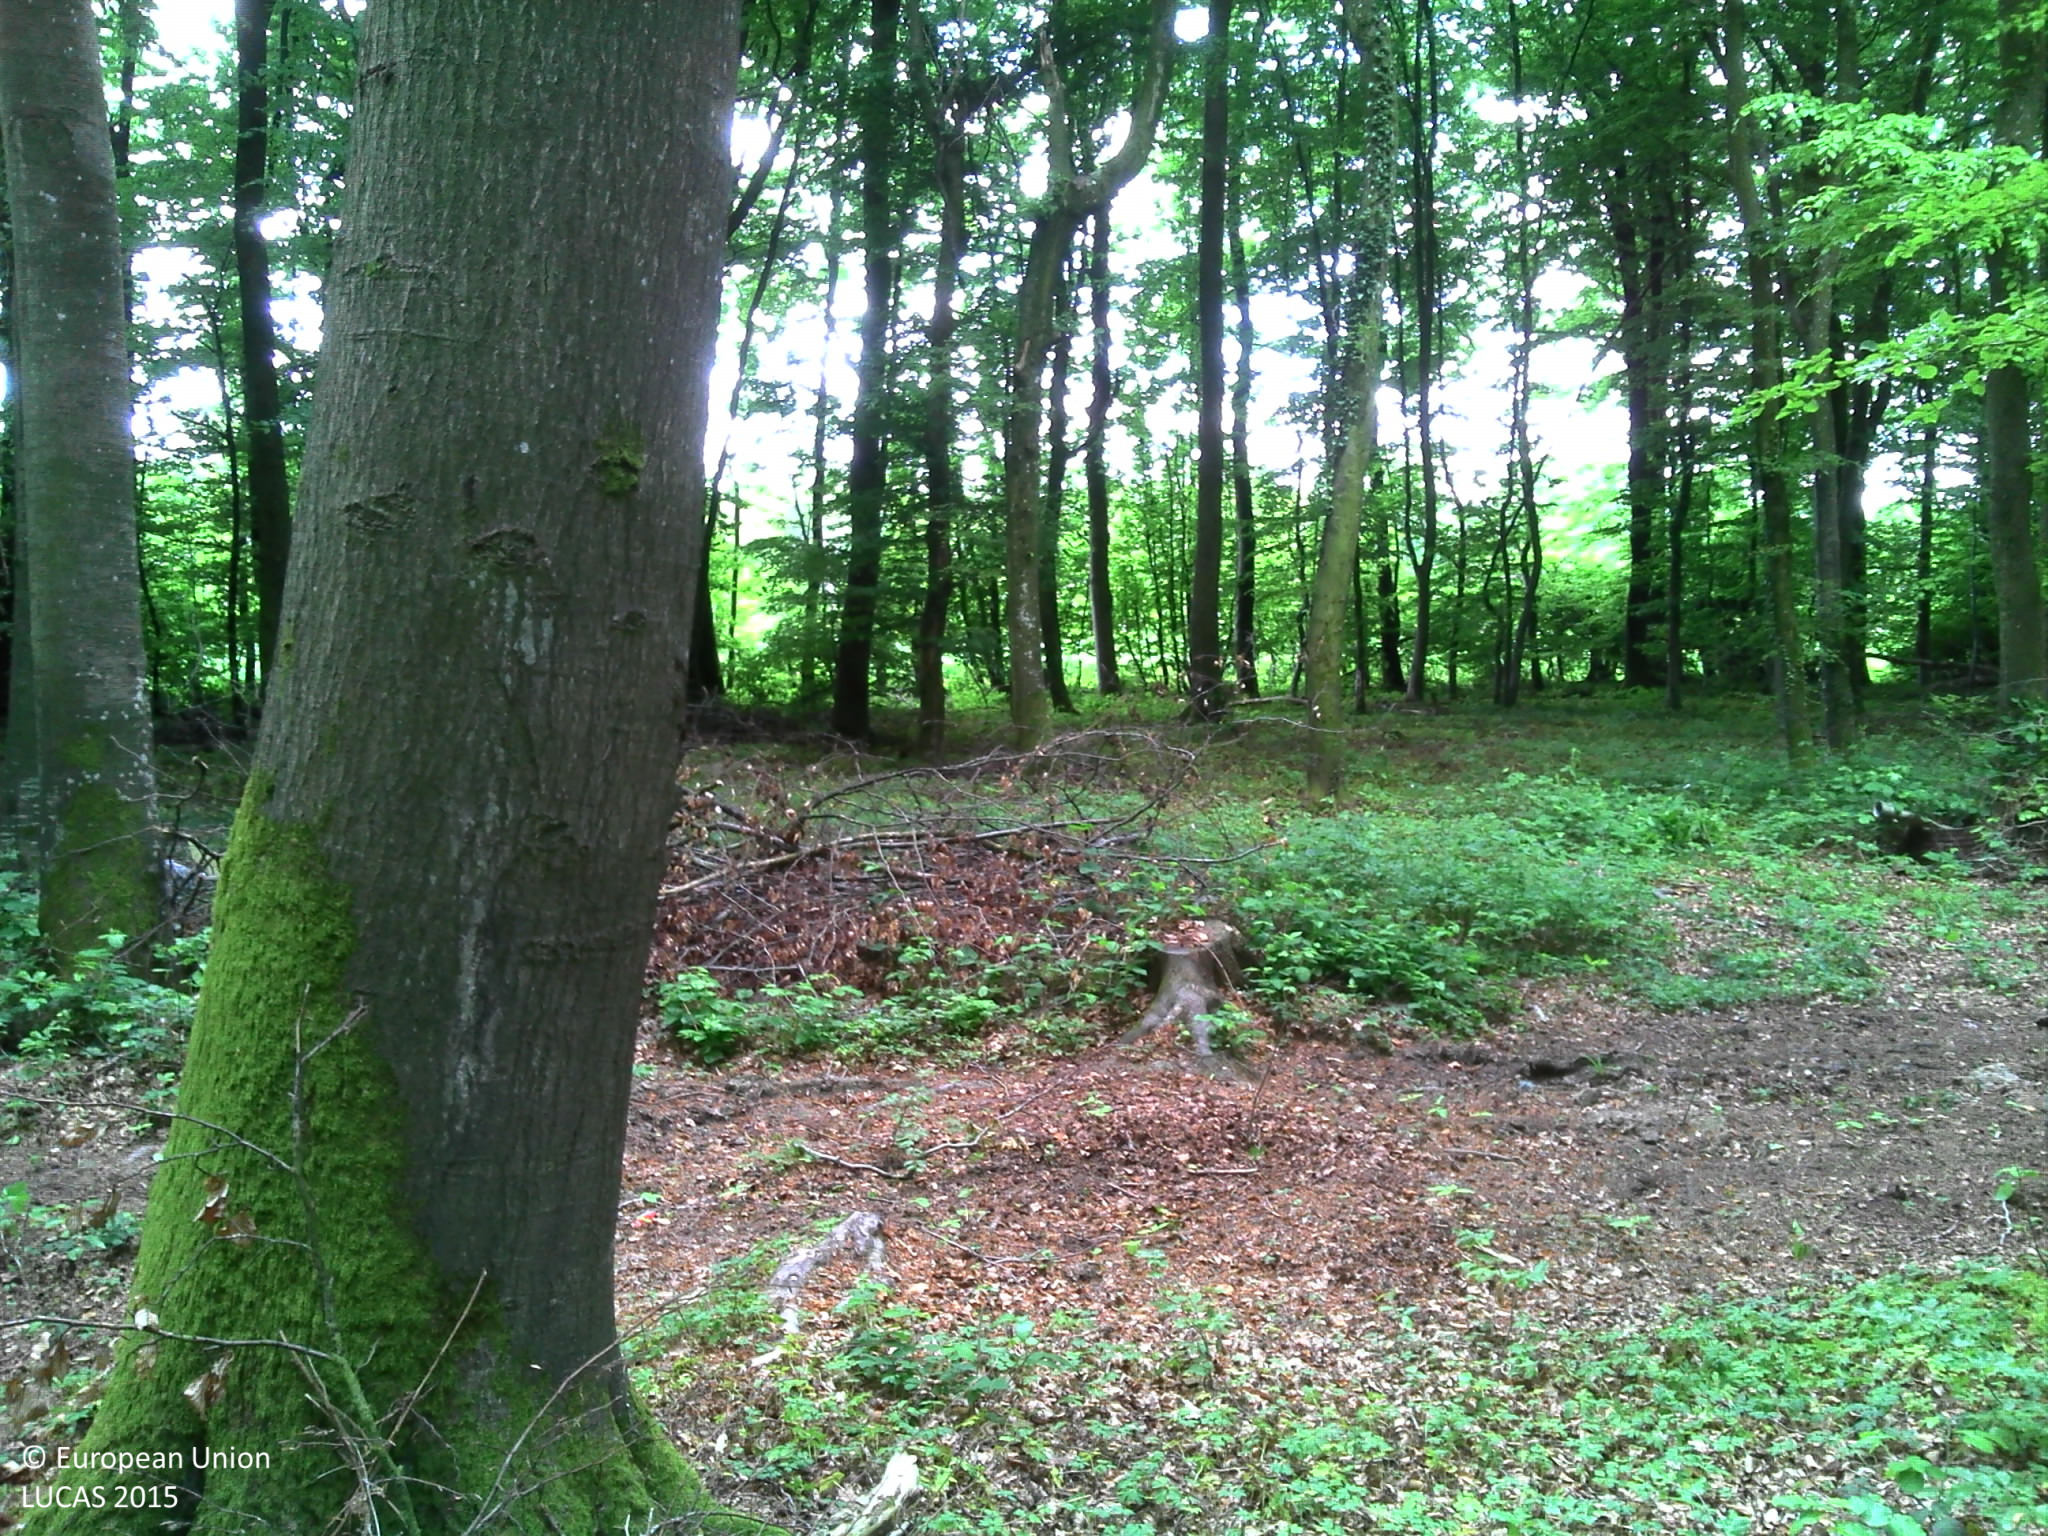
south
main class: Woodland
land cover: Broadleaved woodland
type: beech forest
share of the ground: > 75 %
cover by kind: broadleaved forest trees 85 %, herbaceous plants 10 %, lichens and mosses 5 %
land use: Forestry
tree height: > 5 m
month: May
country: LU
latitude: 49.7685
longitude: 5.9032
